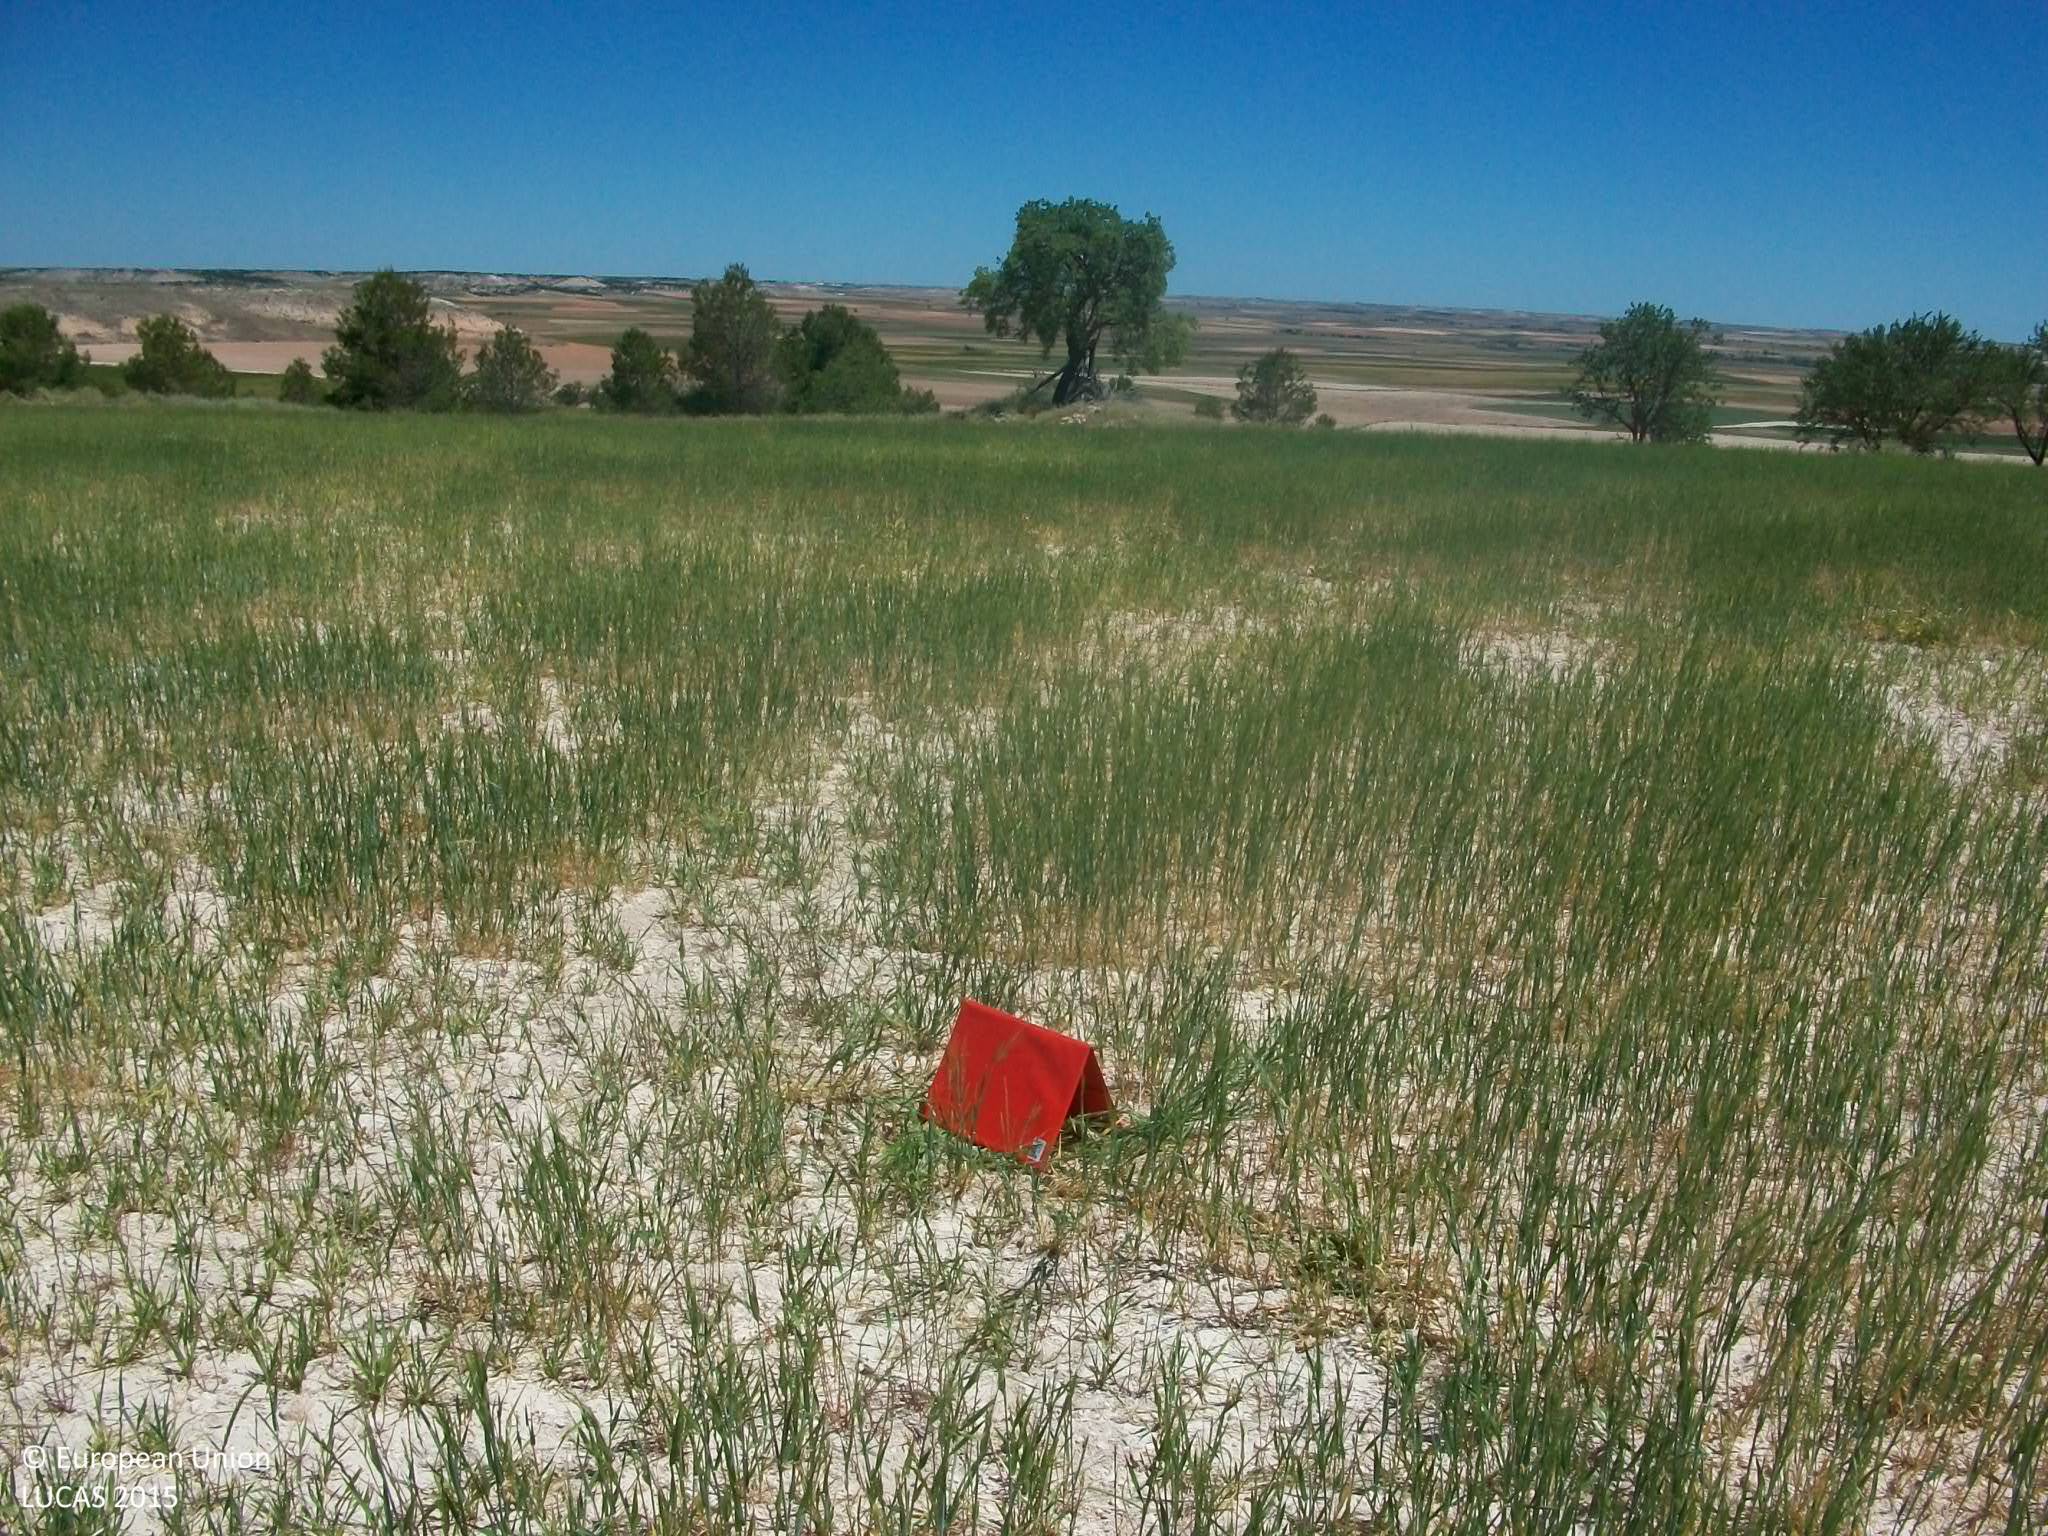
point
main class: Cropland
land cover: Common wheat
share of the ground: 50 - 75 %
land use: Agriculture (excluding fallow land and kitchen gardens)
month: May
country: ES
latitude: 39.6870
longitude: -3.5635
